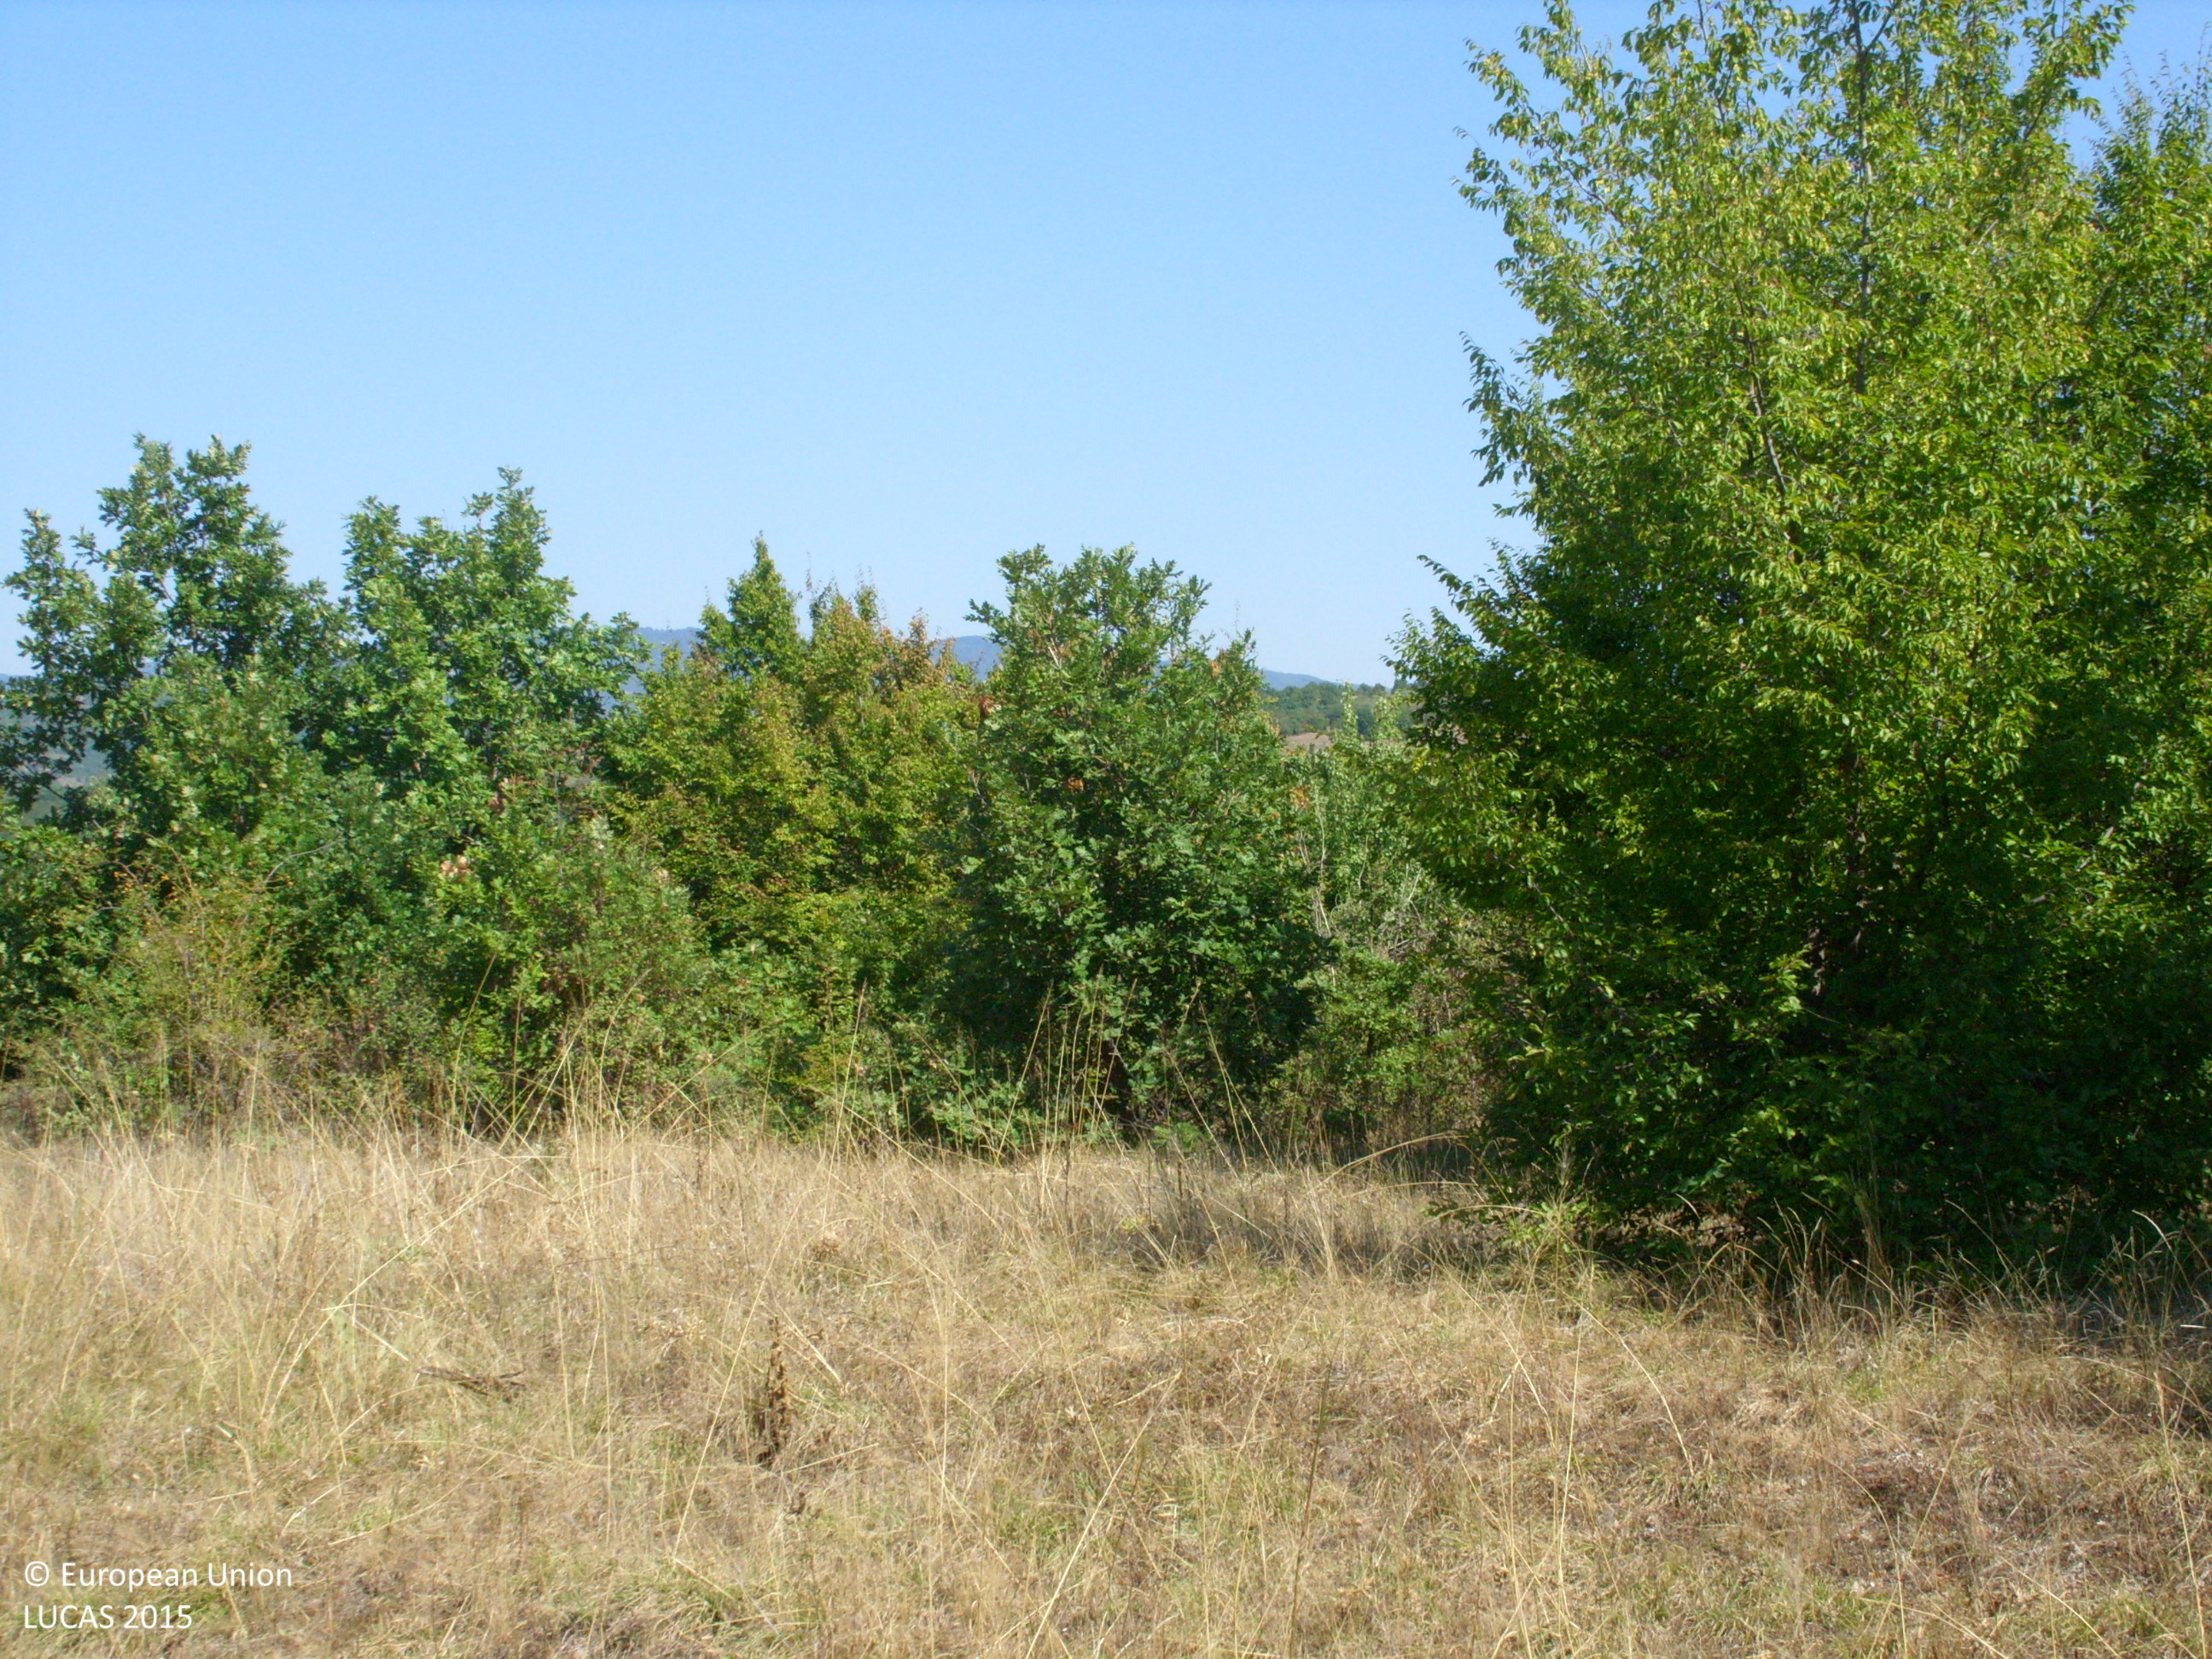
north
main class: Grassland
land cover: Grassland with sparse tree/shrub cover
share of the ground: > 75 %
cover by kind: herbaceous plants 85 %, shrubs 10 %, broadleaved forest trees 5 %
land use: Semi-natural and natural areas not in use
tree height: < 5 m
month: August
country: BG
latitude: 42.4142
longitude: 25.0929
